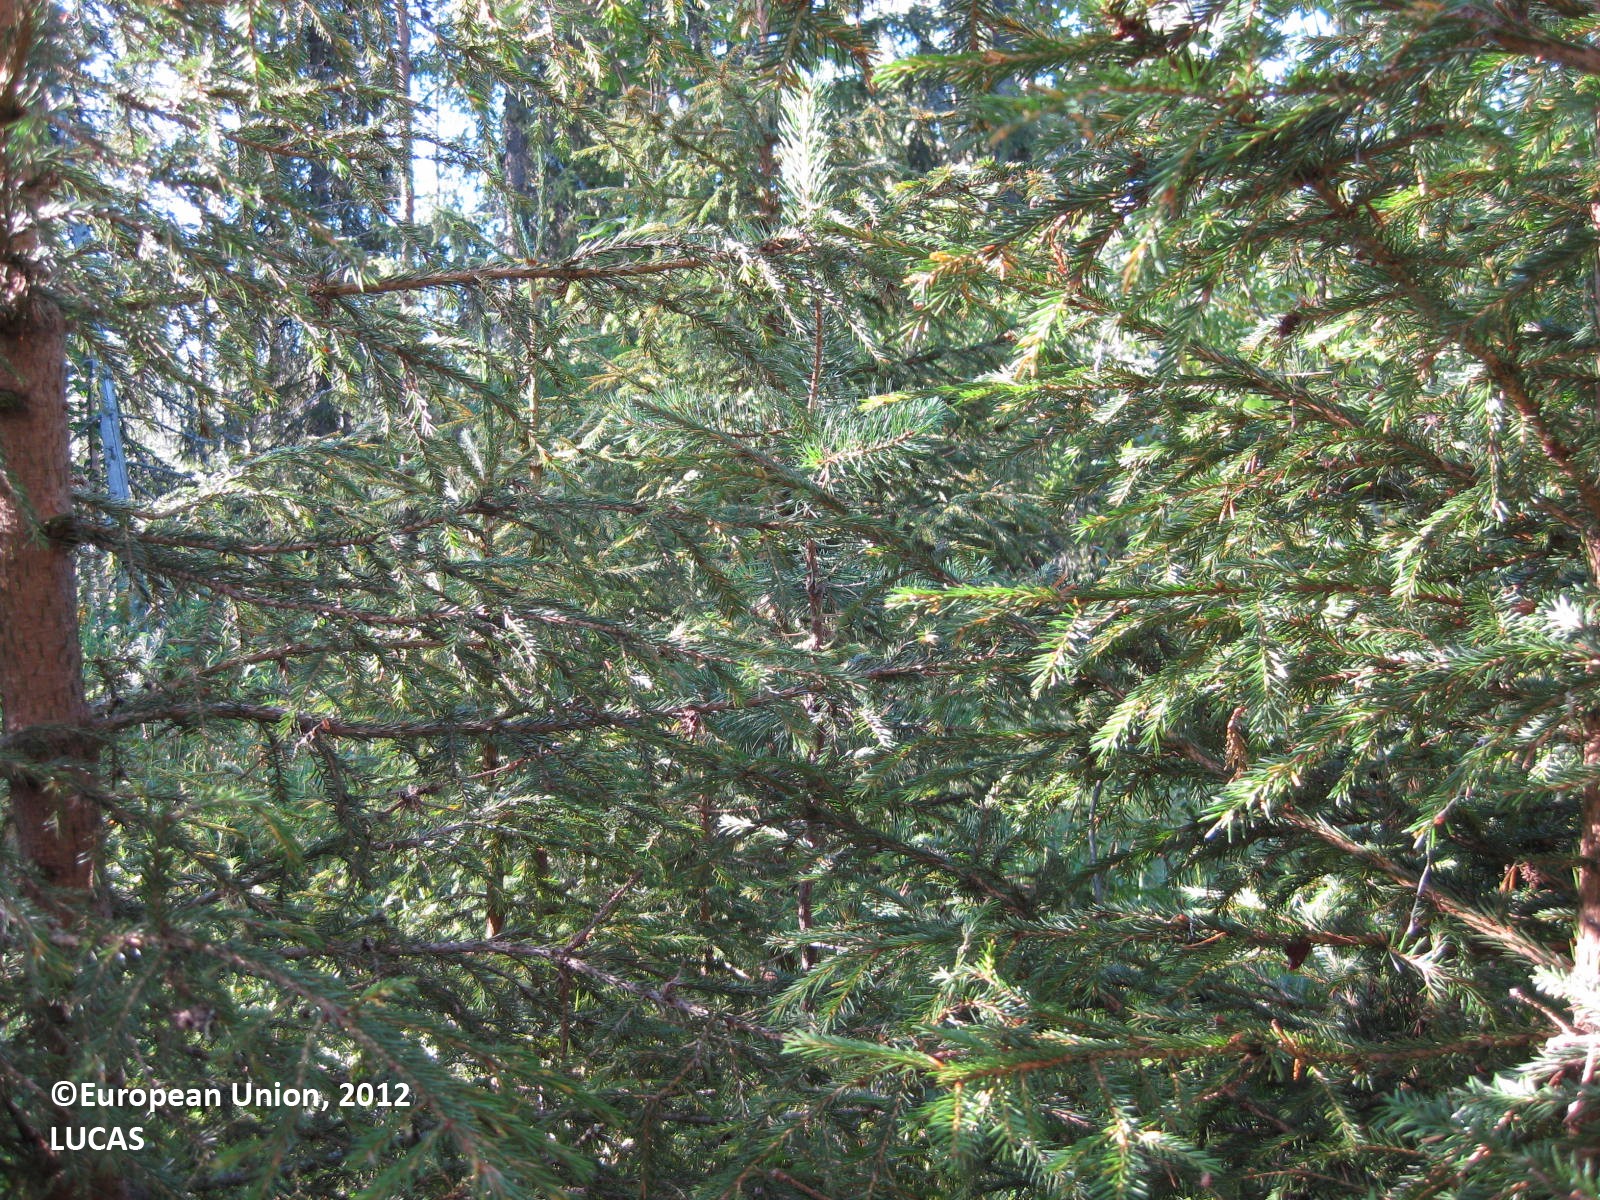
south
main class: Woodland
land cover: Other coniferous woodland
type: boreal forest
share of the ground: > 75 %
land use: Forestry
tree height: > 5 m
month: August
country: FI
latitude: 66.5398
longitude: 28.5836
